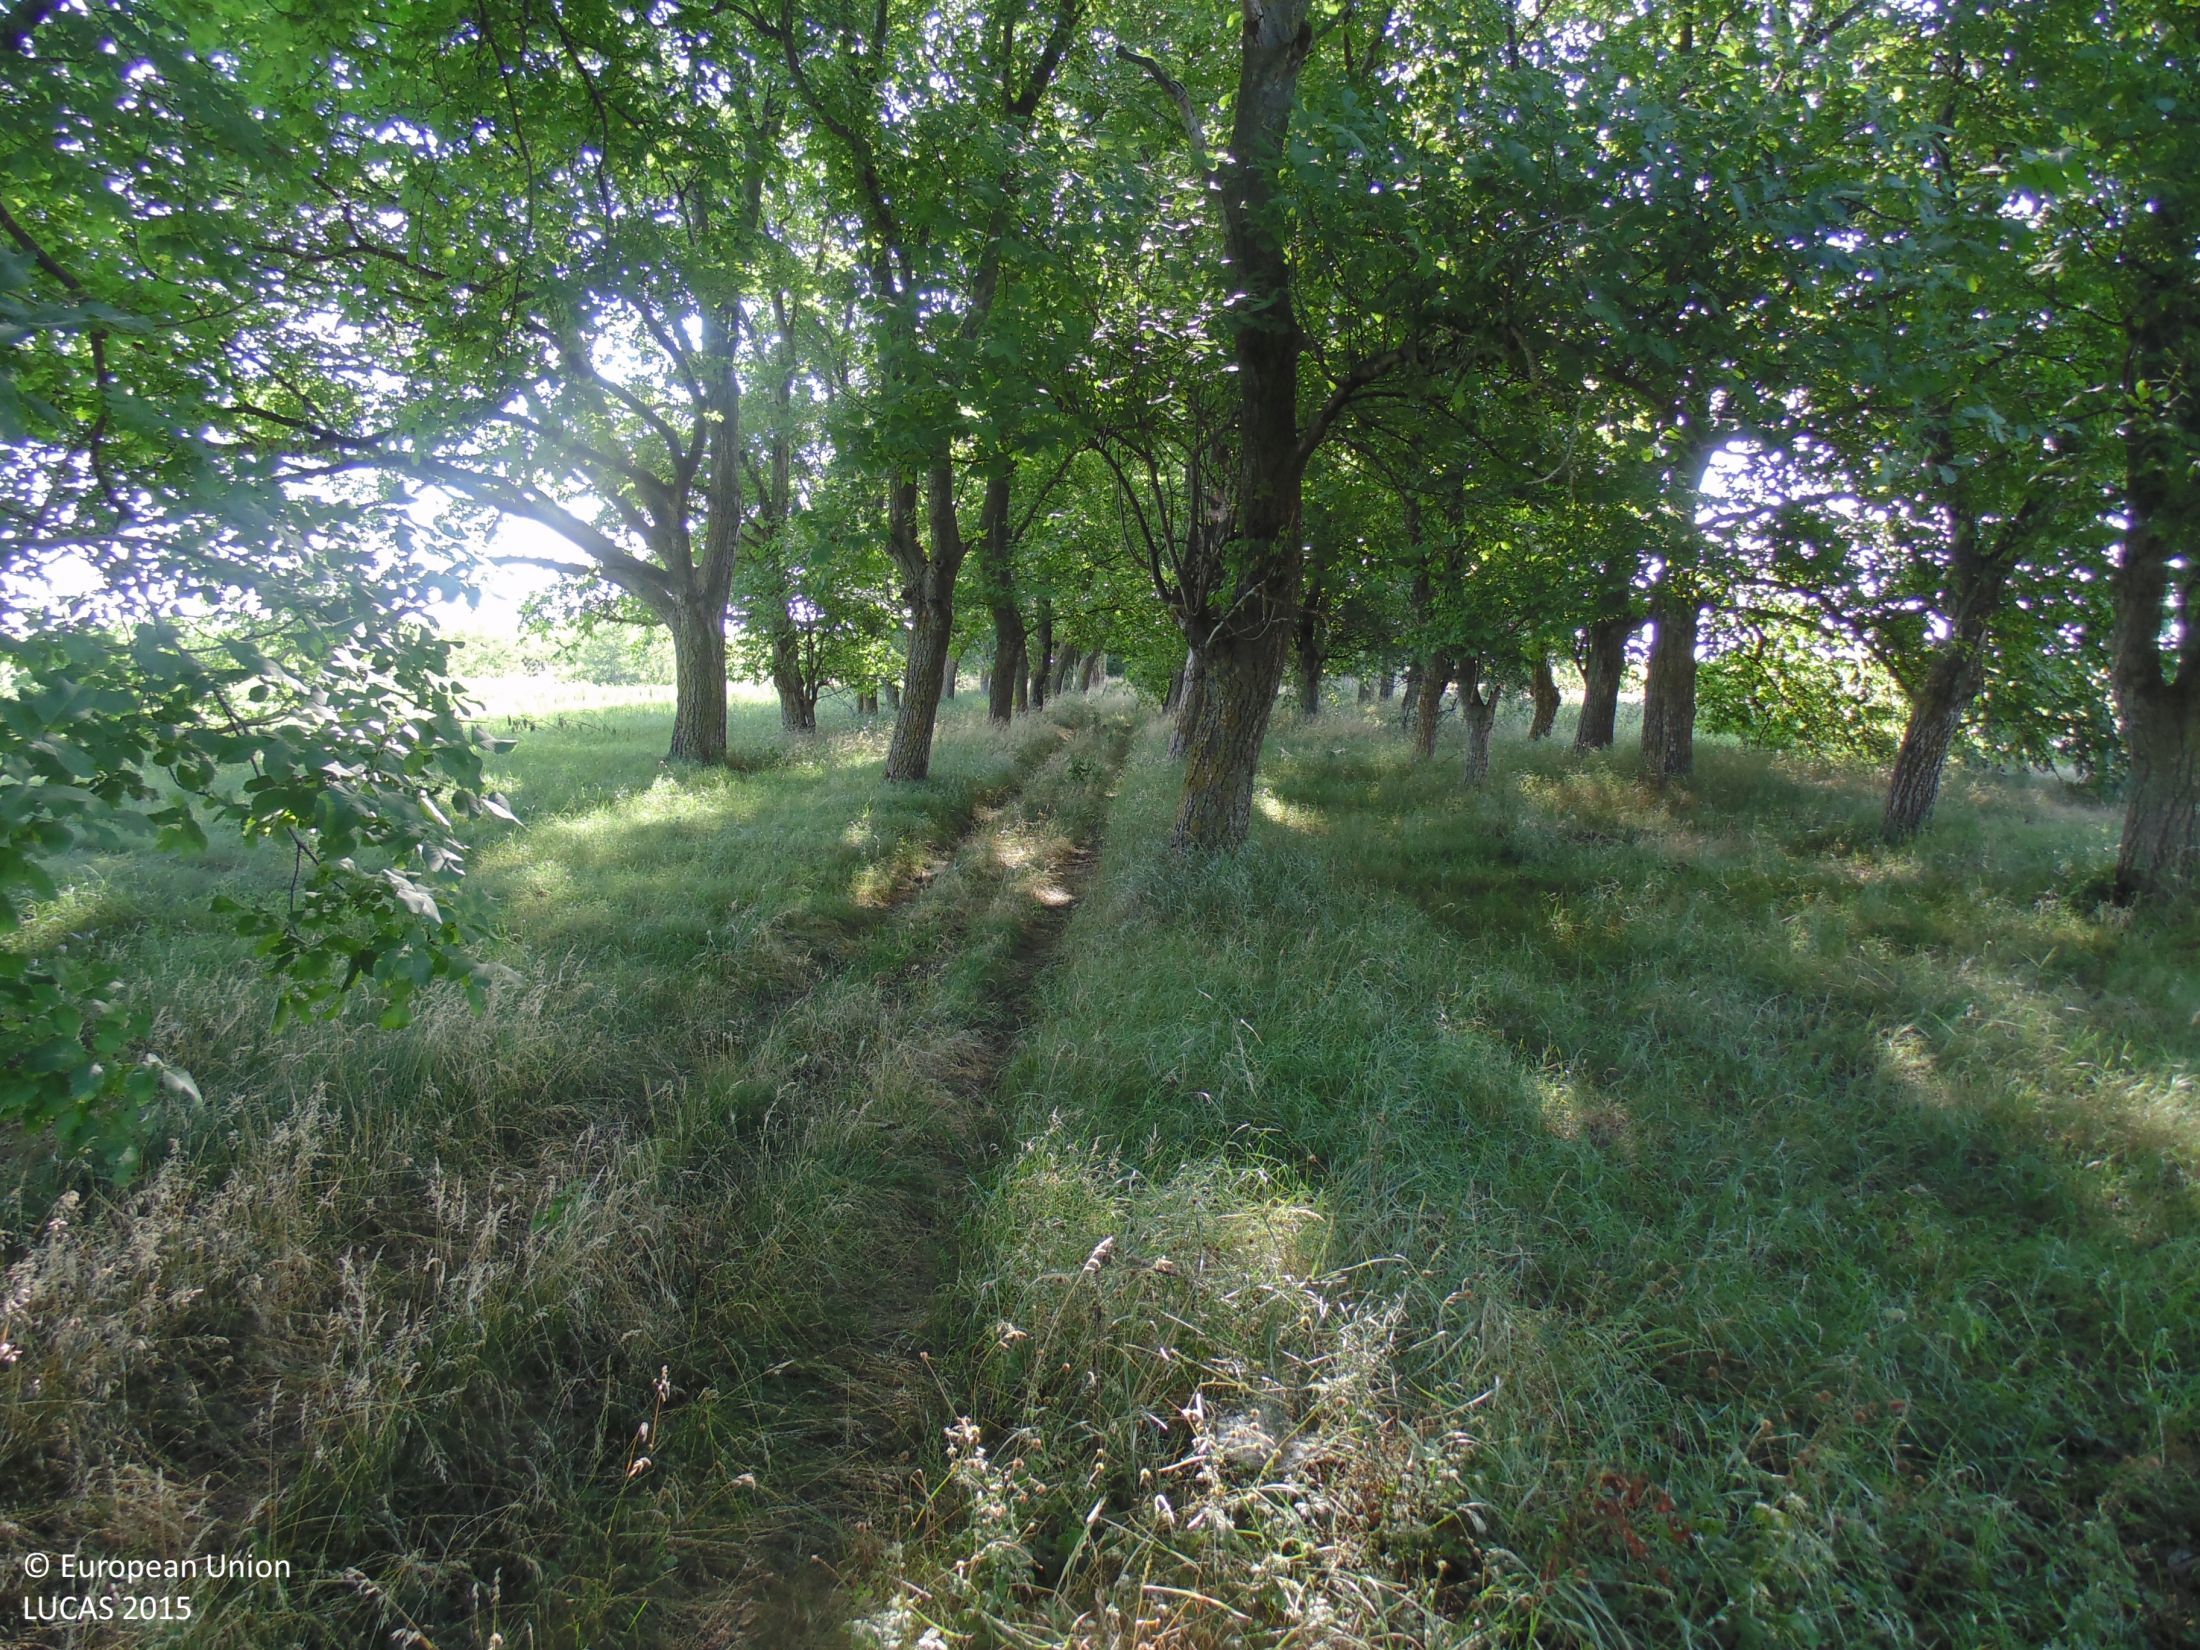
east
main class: Cropland
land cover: Nuts trees
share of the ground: > 75 %
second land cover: Grassland without tree/shrub cover
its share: > 75 %
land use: Agriculture (excluding fallow land and kitchen gardens)
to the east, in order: Nuts trees; Grassland without tree/shrub cover; Tracks; Spontaneously vegetated surfaces; Grassland with sparse tree/shrub cover
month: July
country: BG
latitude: 43.6738
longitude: 27.8423
